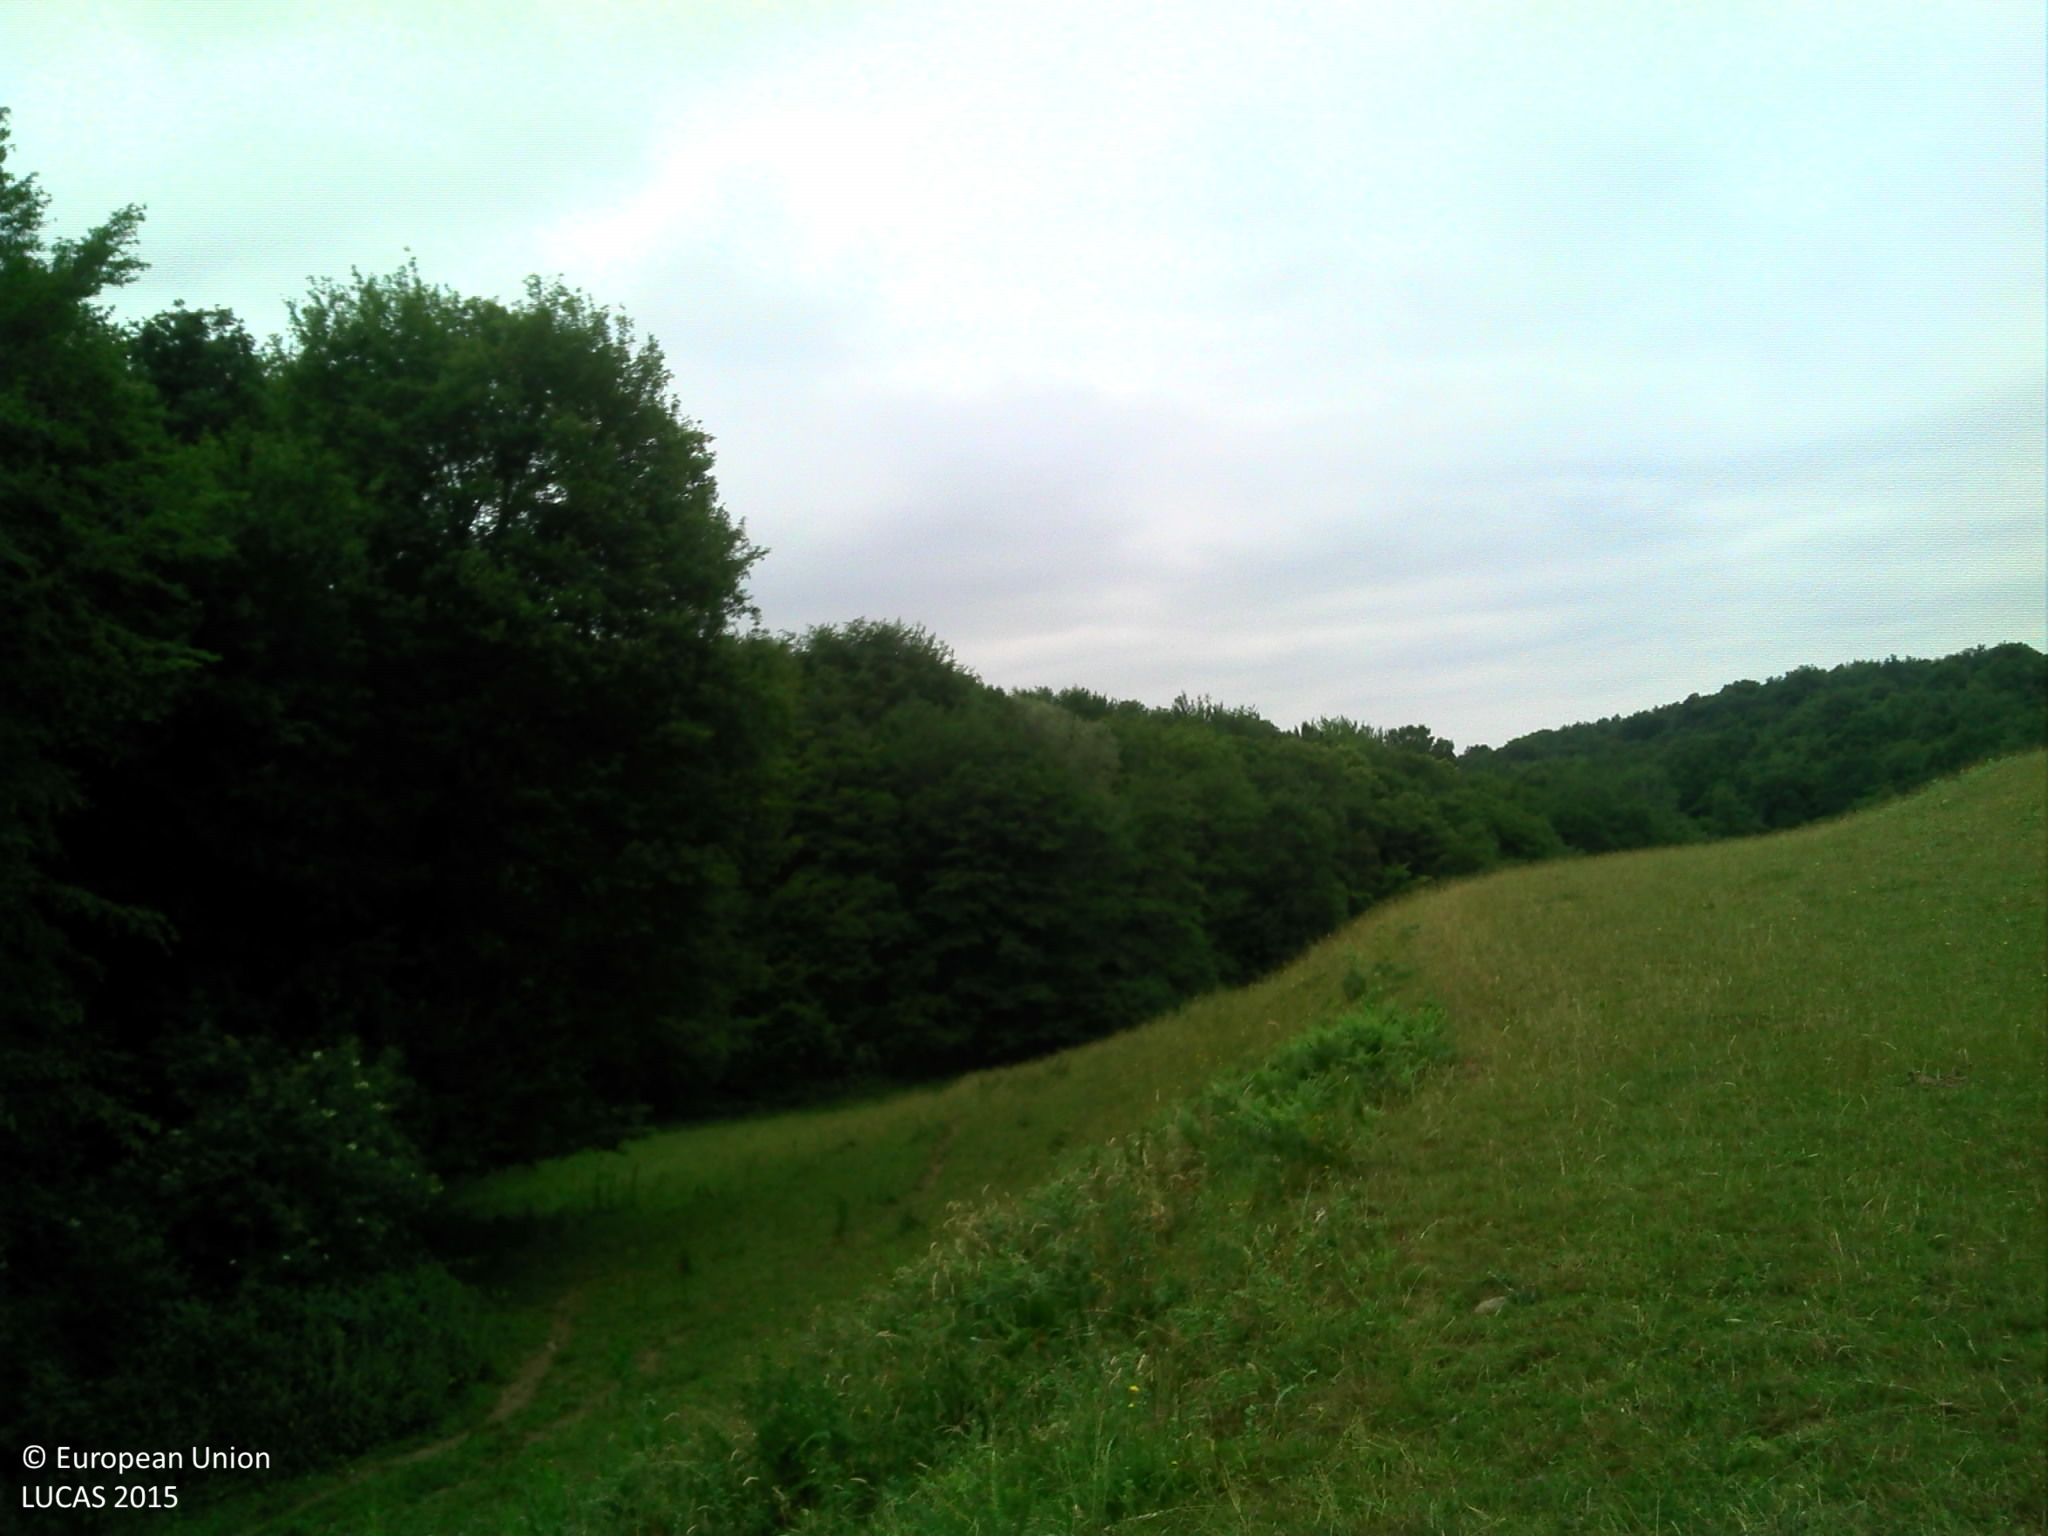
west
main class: Grassland
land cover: Grassland without tree/shrub cover
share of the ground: > 75 %
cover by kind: herbaceous plants 100 %
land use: Agriculture (excluding fallow land and kitchen gardens)
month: June
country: FR
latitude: 46.5303
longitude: 4.7737
